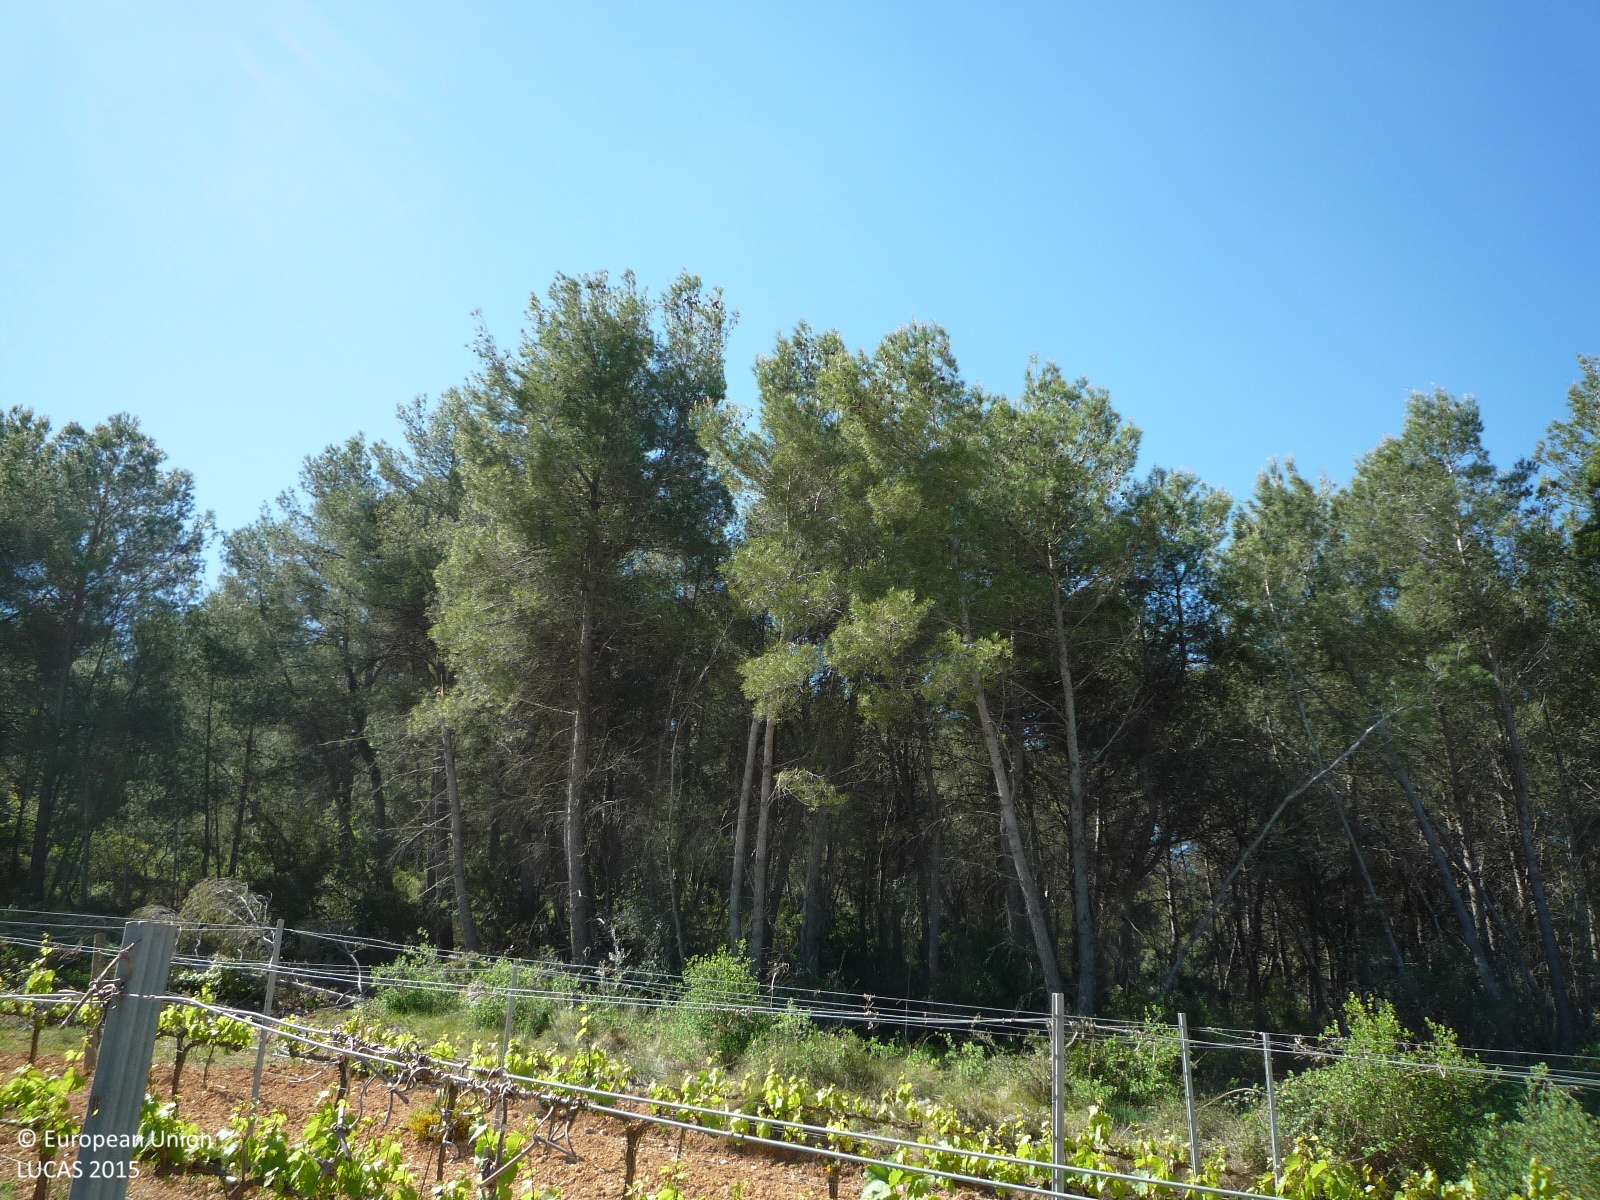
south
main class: Cropland
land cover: Vineyards
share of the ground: > 75 %
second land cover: Spontaneously vegetated surfaces
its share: 10 - 25 %
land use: Agriculture (excluding fallow land and kitchen gardens)
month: April
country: ES
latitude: 41.3776
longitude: 1.5872
